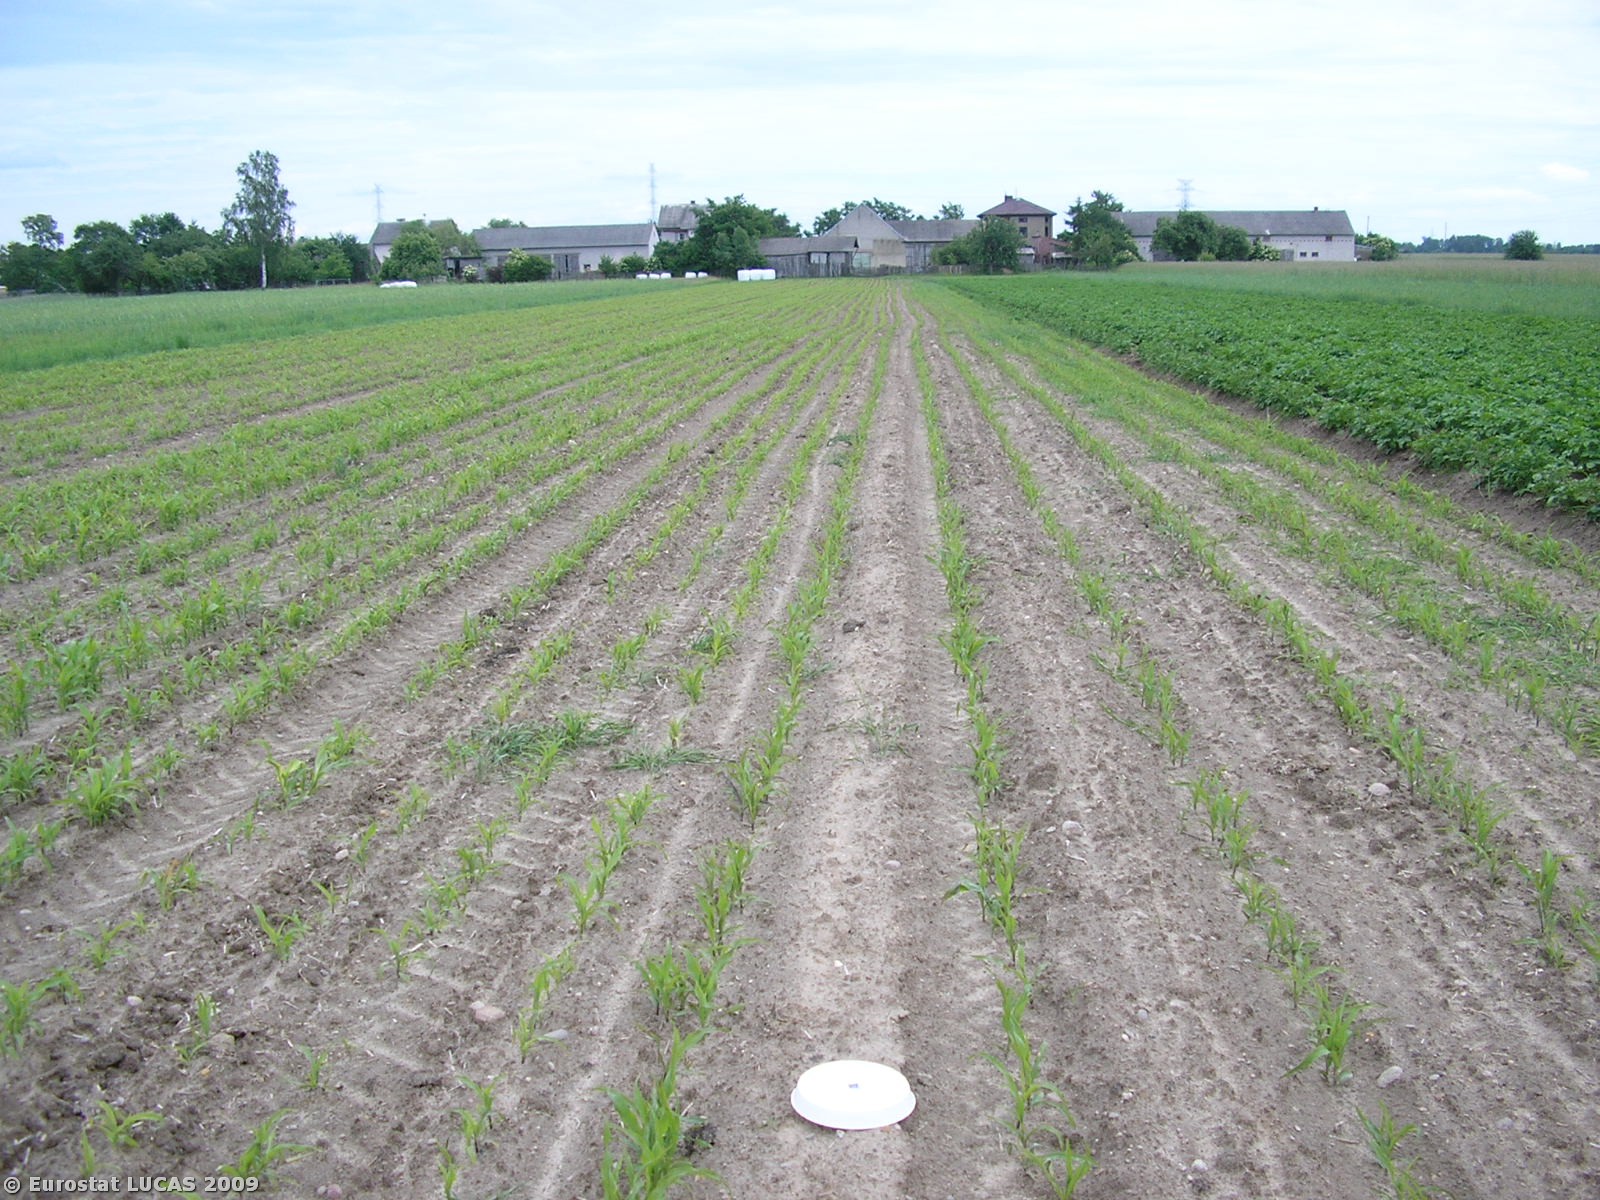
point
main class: Cropland
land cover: Maize
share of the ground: 10 - 25 %
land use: Agriculture (excluding fallow land and kitchen gardens)
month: June
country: PL
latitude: 51.3344
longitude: 18.9363
